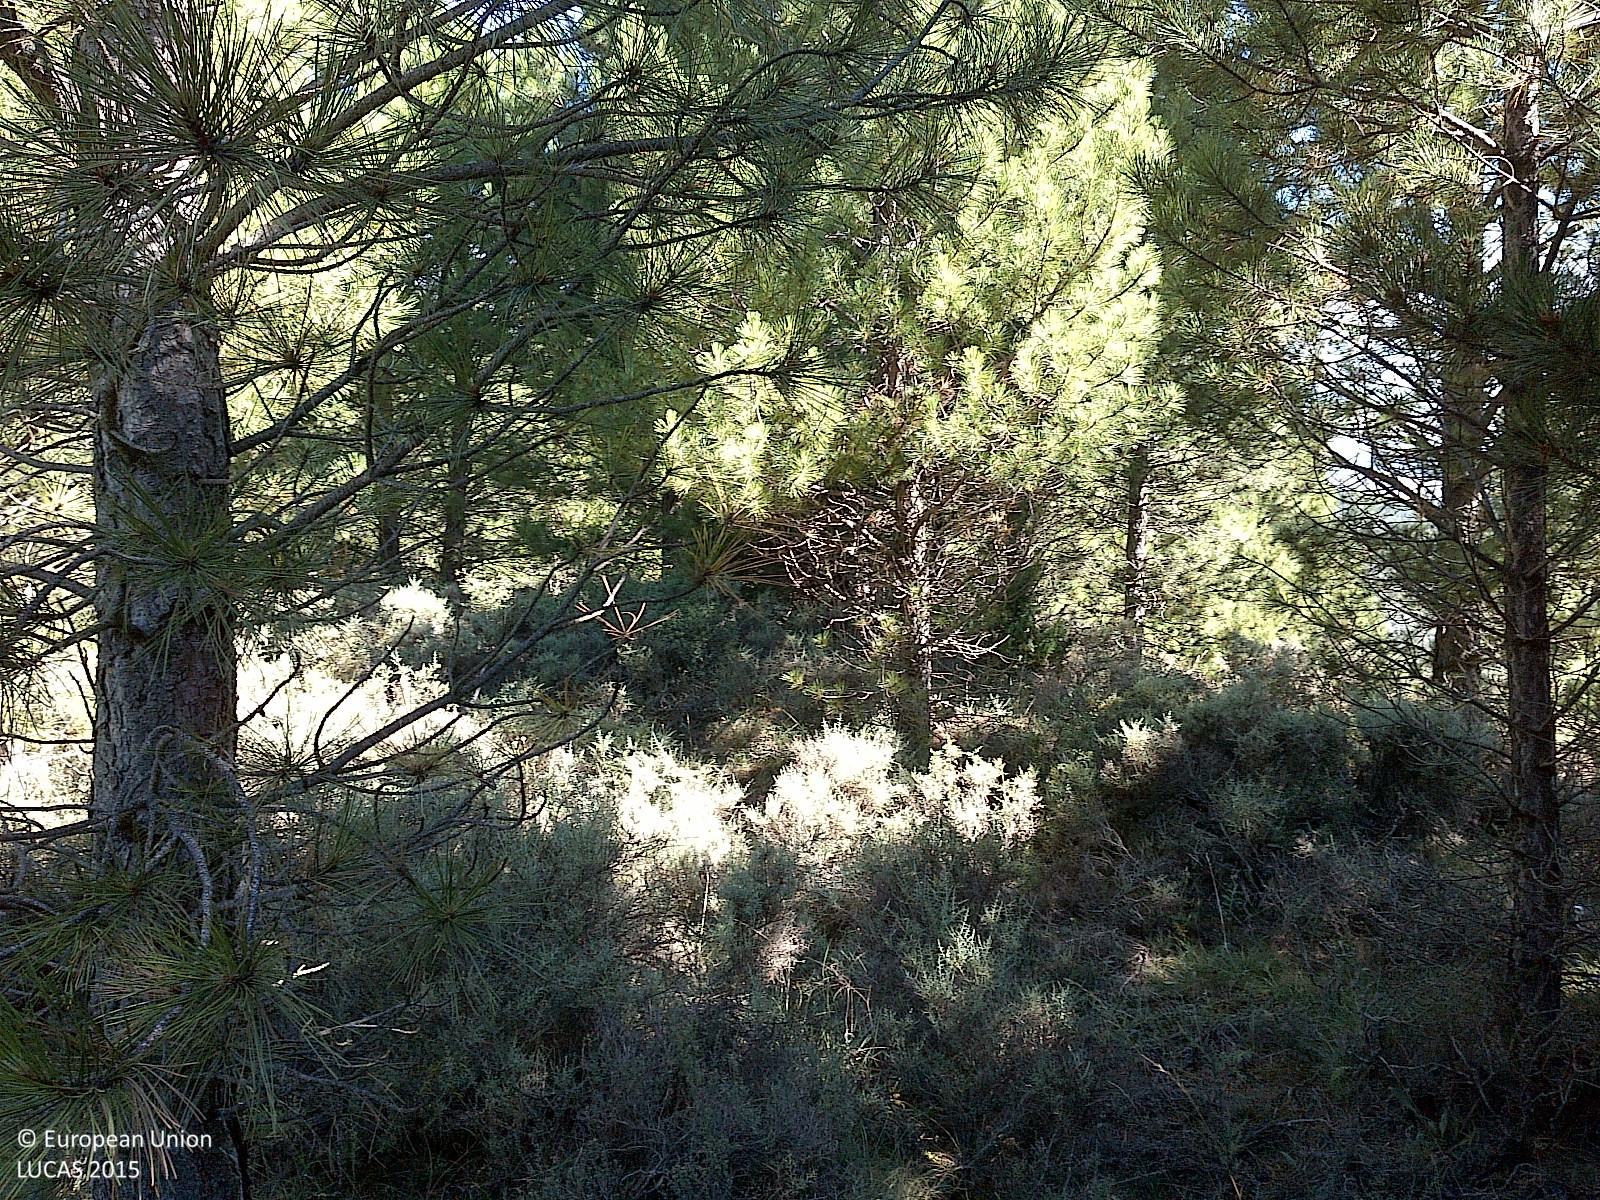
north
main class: Woodland
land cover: Pine dominated coniferous woodland
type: coniferous forest of the mediterranean region
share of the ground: 25 - 50 %
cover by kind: shrubs 55 %, coniferous forest trees 35 %, herbaceous plants 10 %
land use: Forestry
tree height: < 5 m
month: July
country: ES
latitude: 41.9668
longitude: -2.2123
